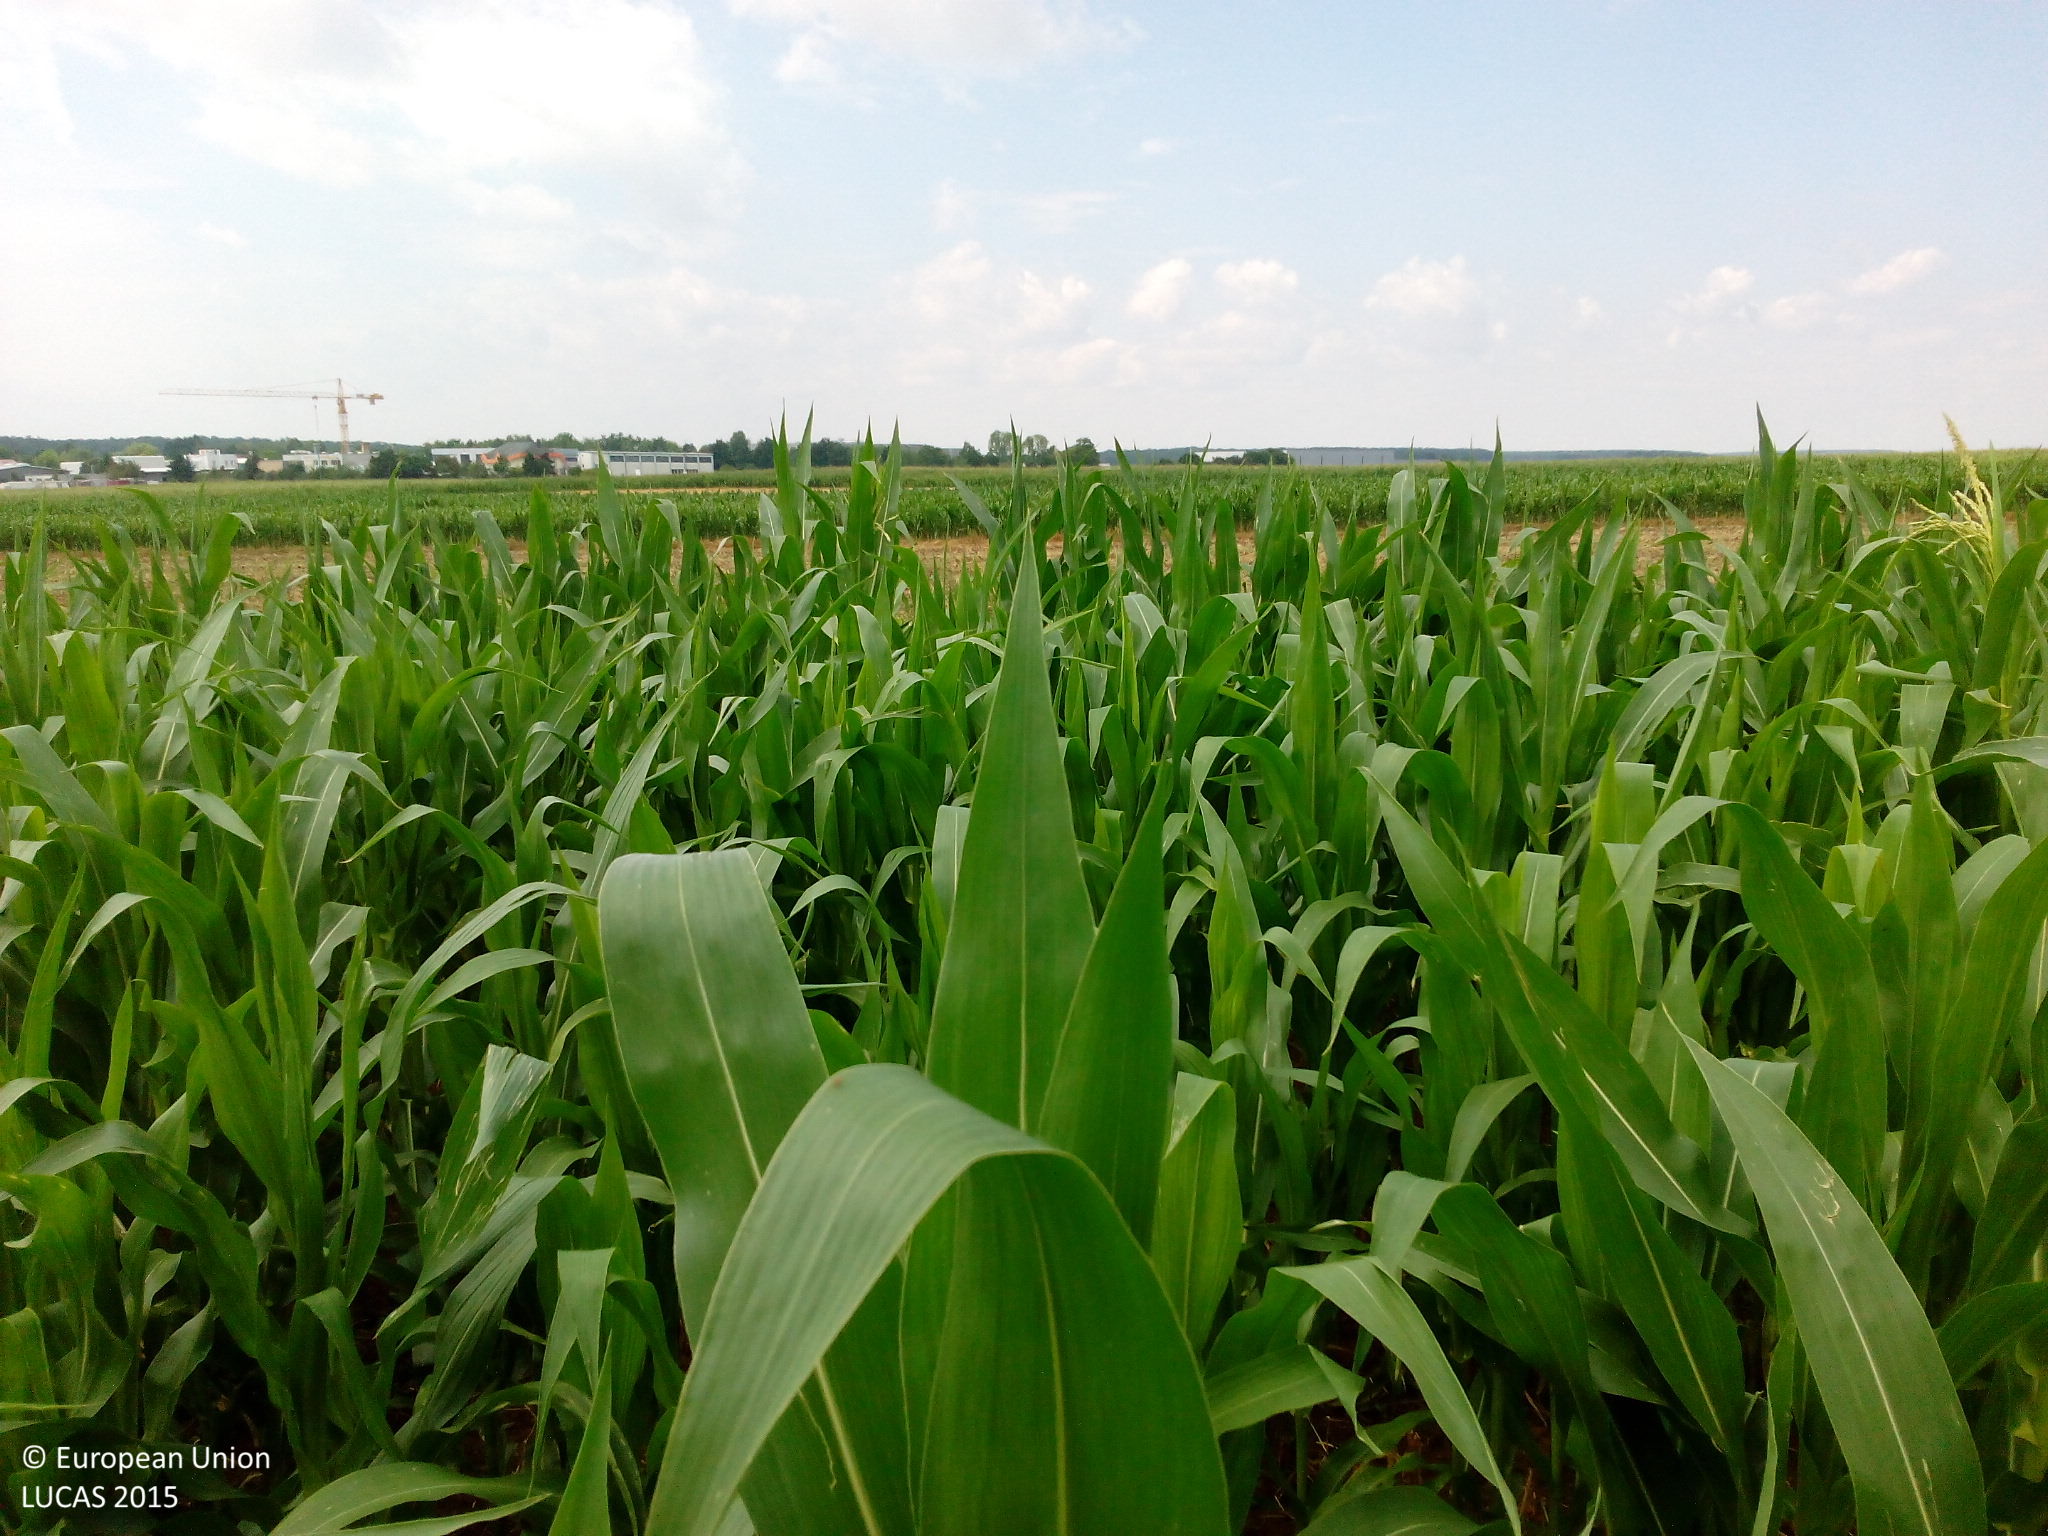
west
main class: Cropland
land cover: Maize
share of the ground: > 75 %
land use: Agriculture (excluding fallow land and kitchen gardens)
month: July
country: DE
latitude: 49.4971
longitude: 10.9247
